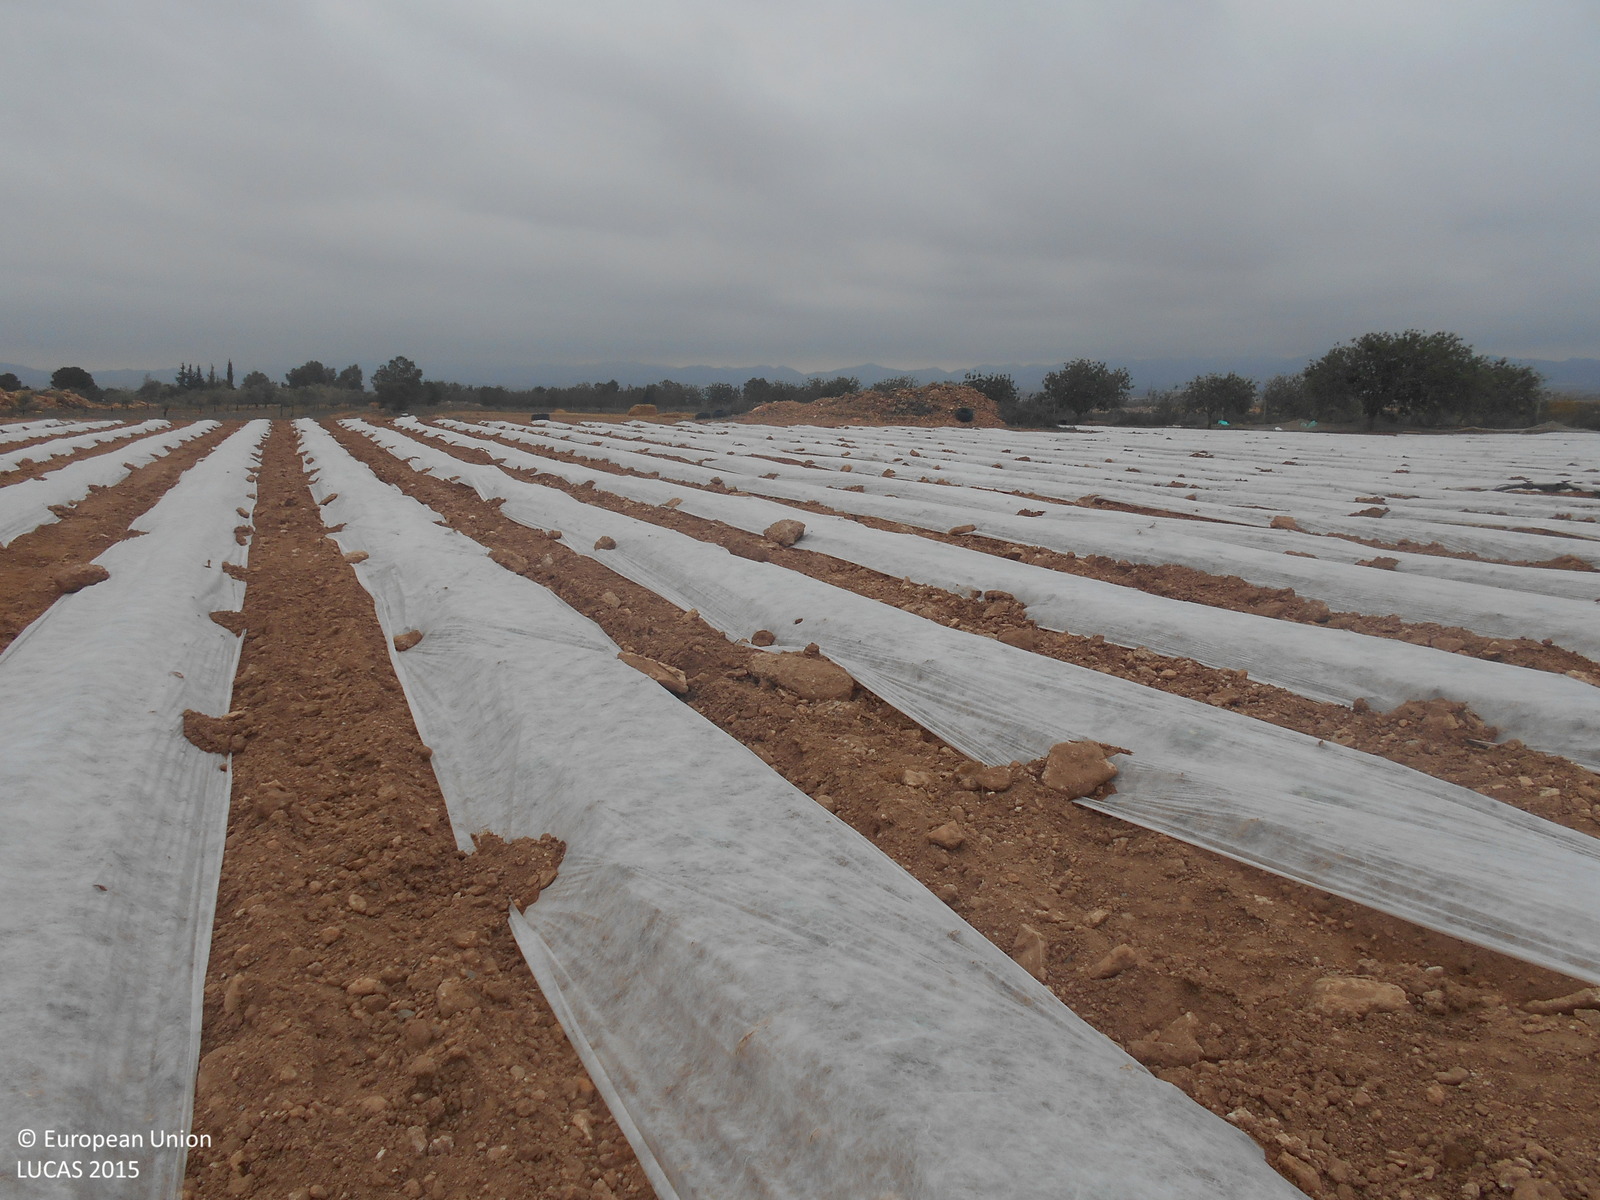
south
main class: Cropland
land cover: Other fresh vegetables
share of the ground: < 10 %
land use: Agriculture (excluding fallow land and kitchen gardens)
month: April
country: ES
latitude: 37.7570
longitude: -1.2298
